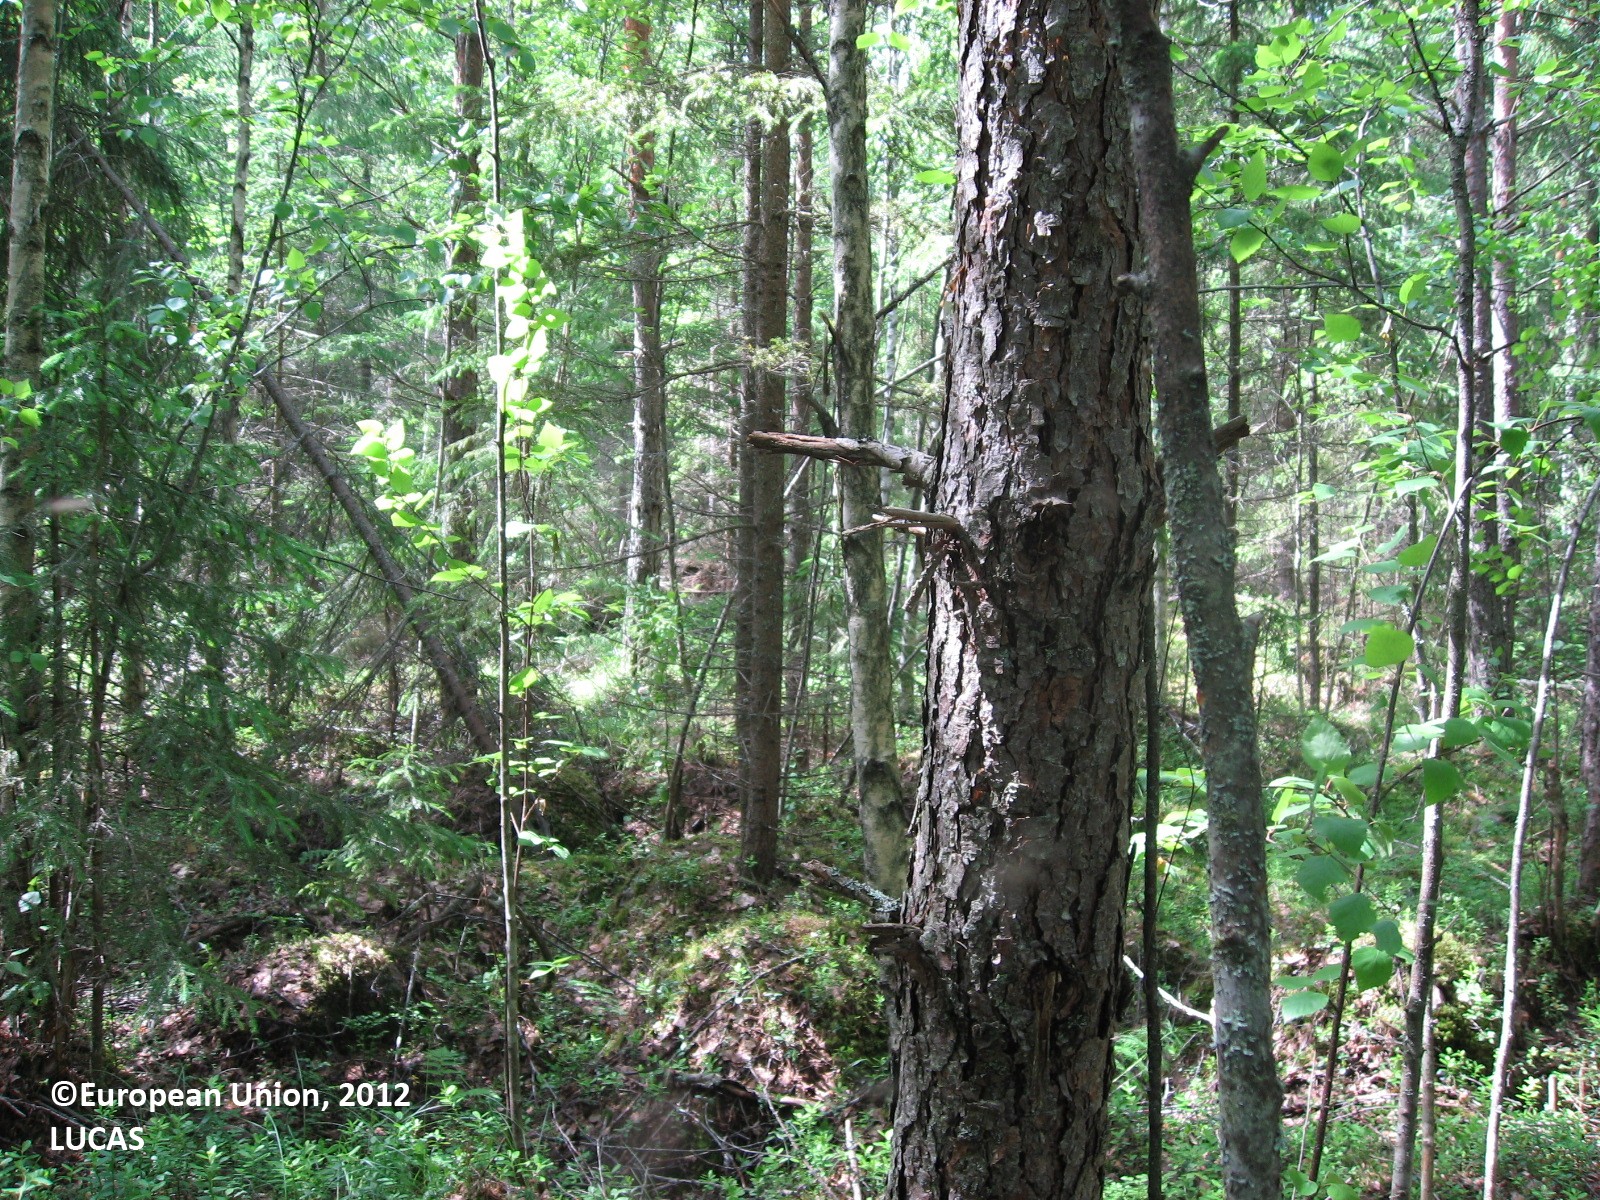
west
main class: Woodland
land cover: Spruce dominated mixed woodland
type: boreal forest
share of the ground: > 75 %
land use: Forestry
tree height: > 5 m
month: June
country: FI
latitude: 60.5522
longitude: 26.2875
